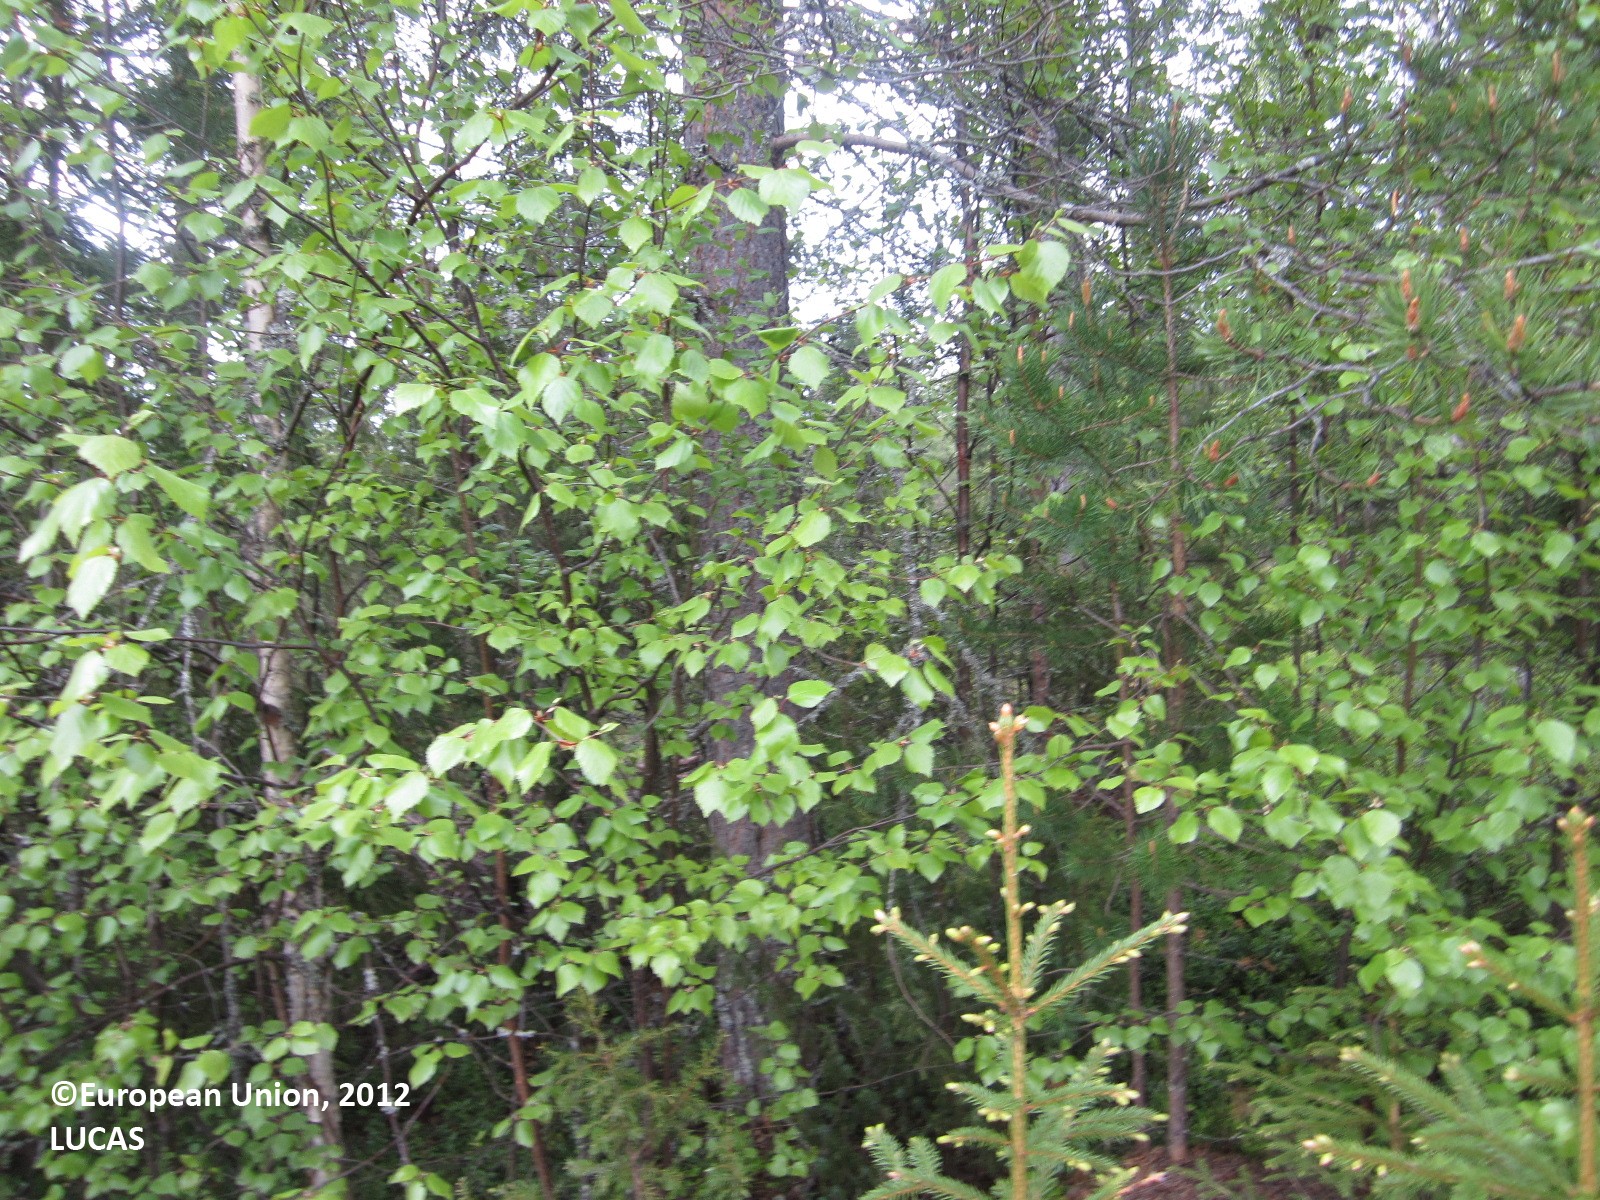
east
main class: Woodland
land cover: Pine dominated mixed woodland
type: boreal forest
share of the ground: > 75 %
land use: Forestry
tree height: > 5 m
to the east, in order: Pine dominated mixed woodland; Pine dominated coniferous woodland; Tracks; Spruce dominated coniferous woodland; Tracks; Broadleaved woodland; Pine dominated mixed woodland; Grass margins; Pine dominated mixed woodland; Ditches and canals; Pine dominated mixed woodland; Shrubland with sparse tree cover; Tracks; Groves; Shrubland with sparse tree cover; Pine dominated mixed woodland
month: June
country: FI
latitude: 64.7728
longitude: 28.7926
